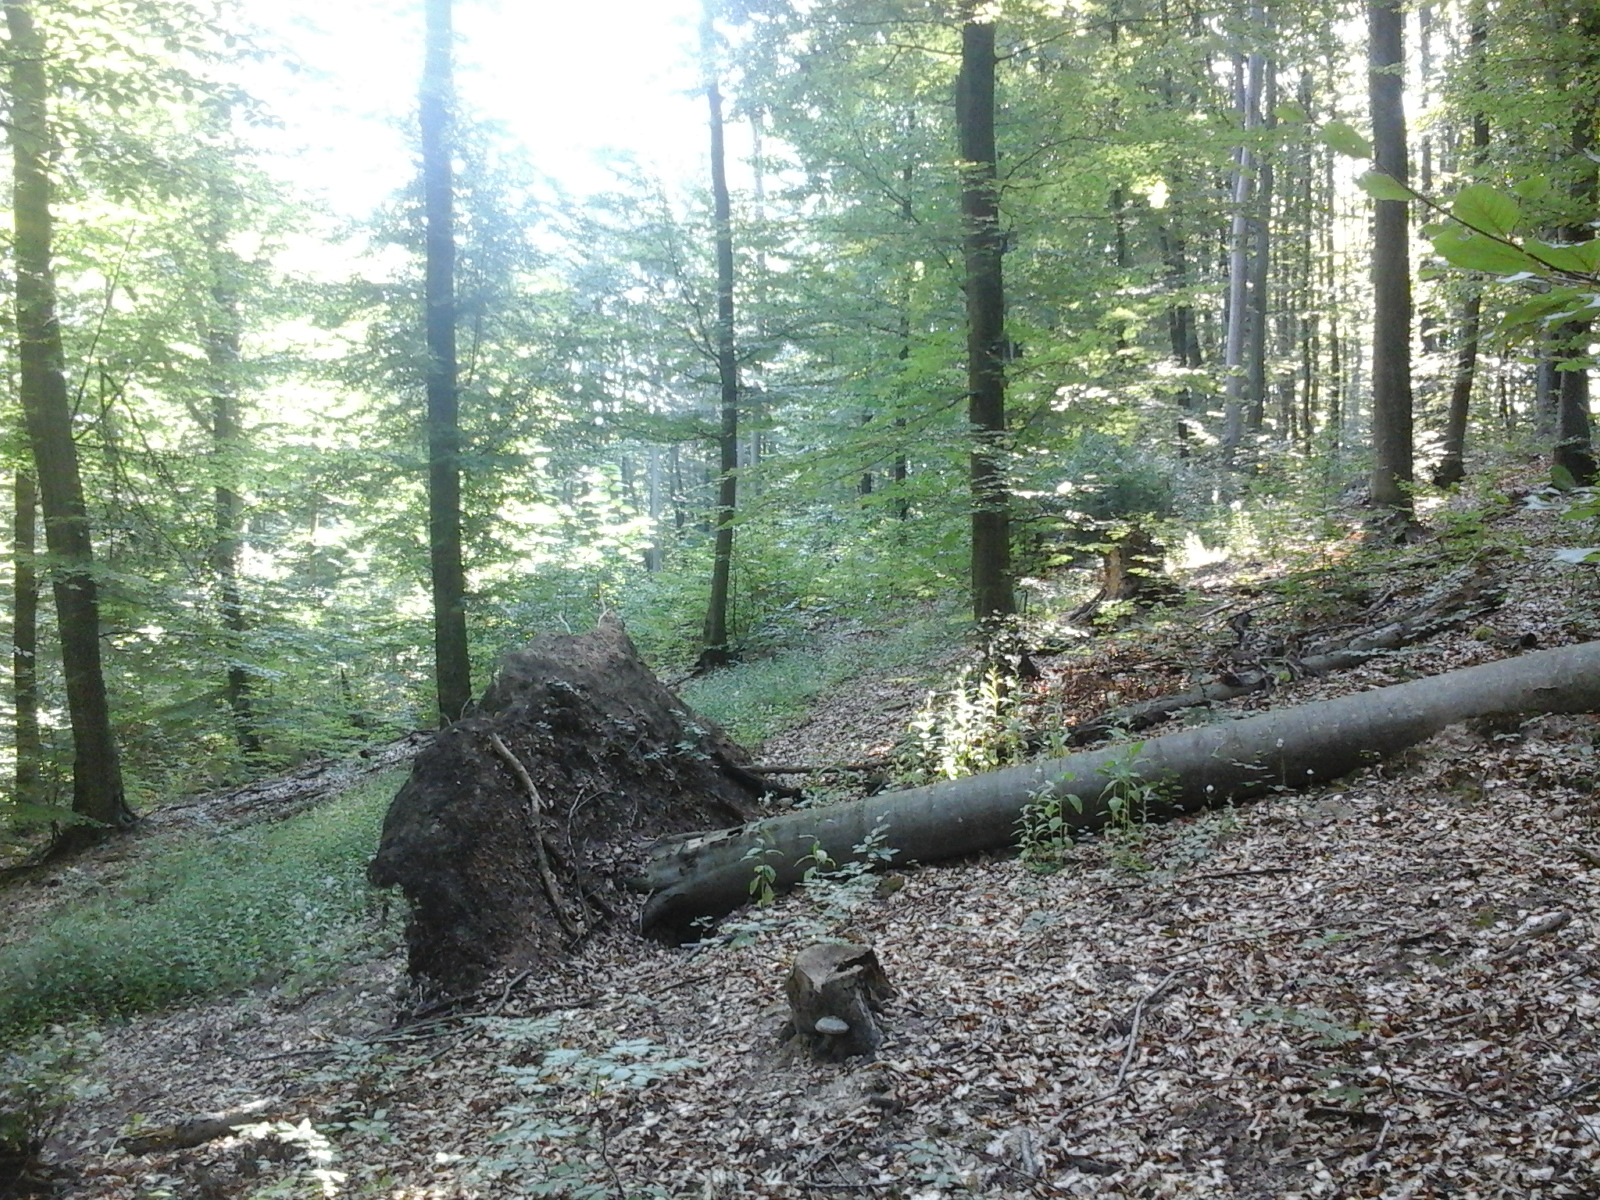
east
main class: Woodland
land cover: Broadleaved woodland
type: beech forest
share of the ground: > 75 %
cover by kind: broadleaved forest trees 100 %
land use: Forestry
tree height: > 5 m
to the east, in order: Broadleaved woodland
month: August
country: RO
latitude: 46.0143
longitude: 22.1980
